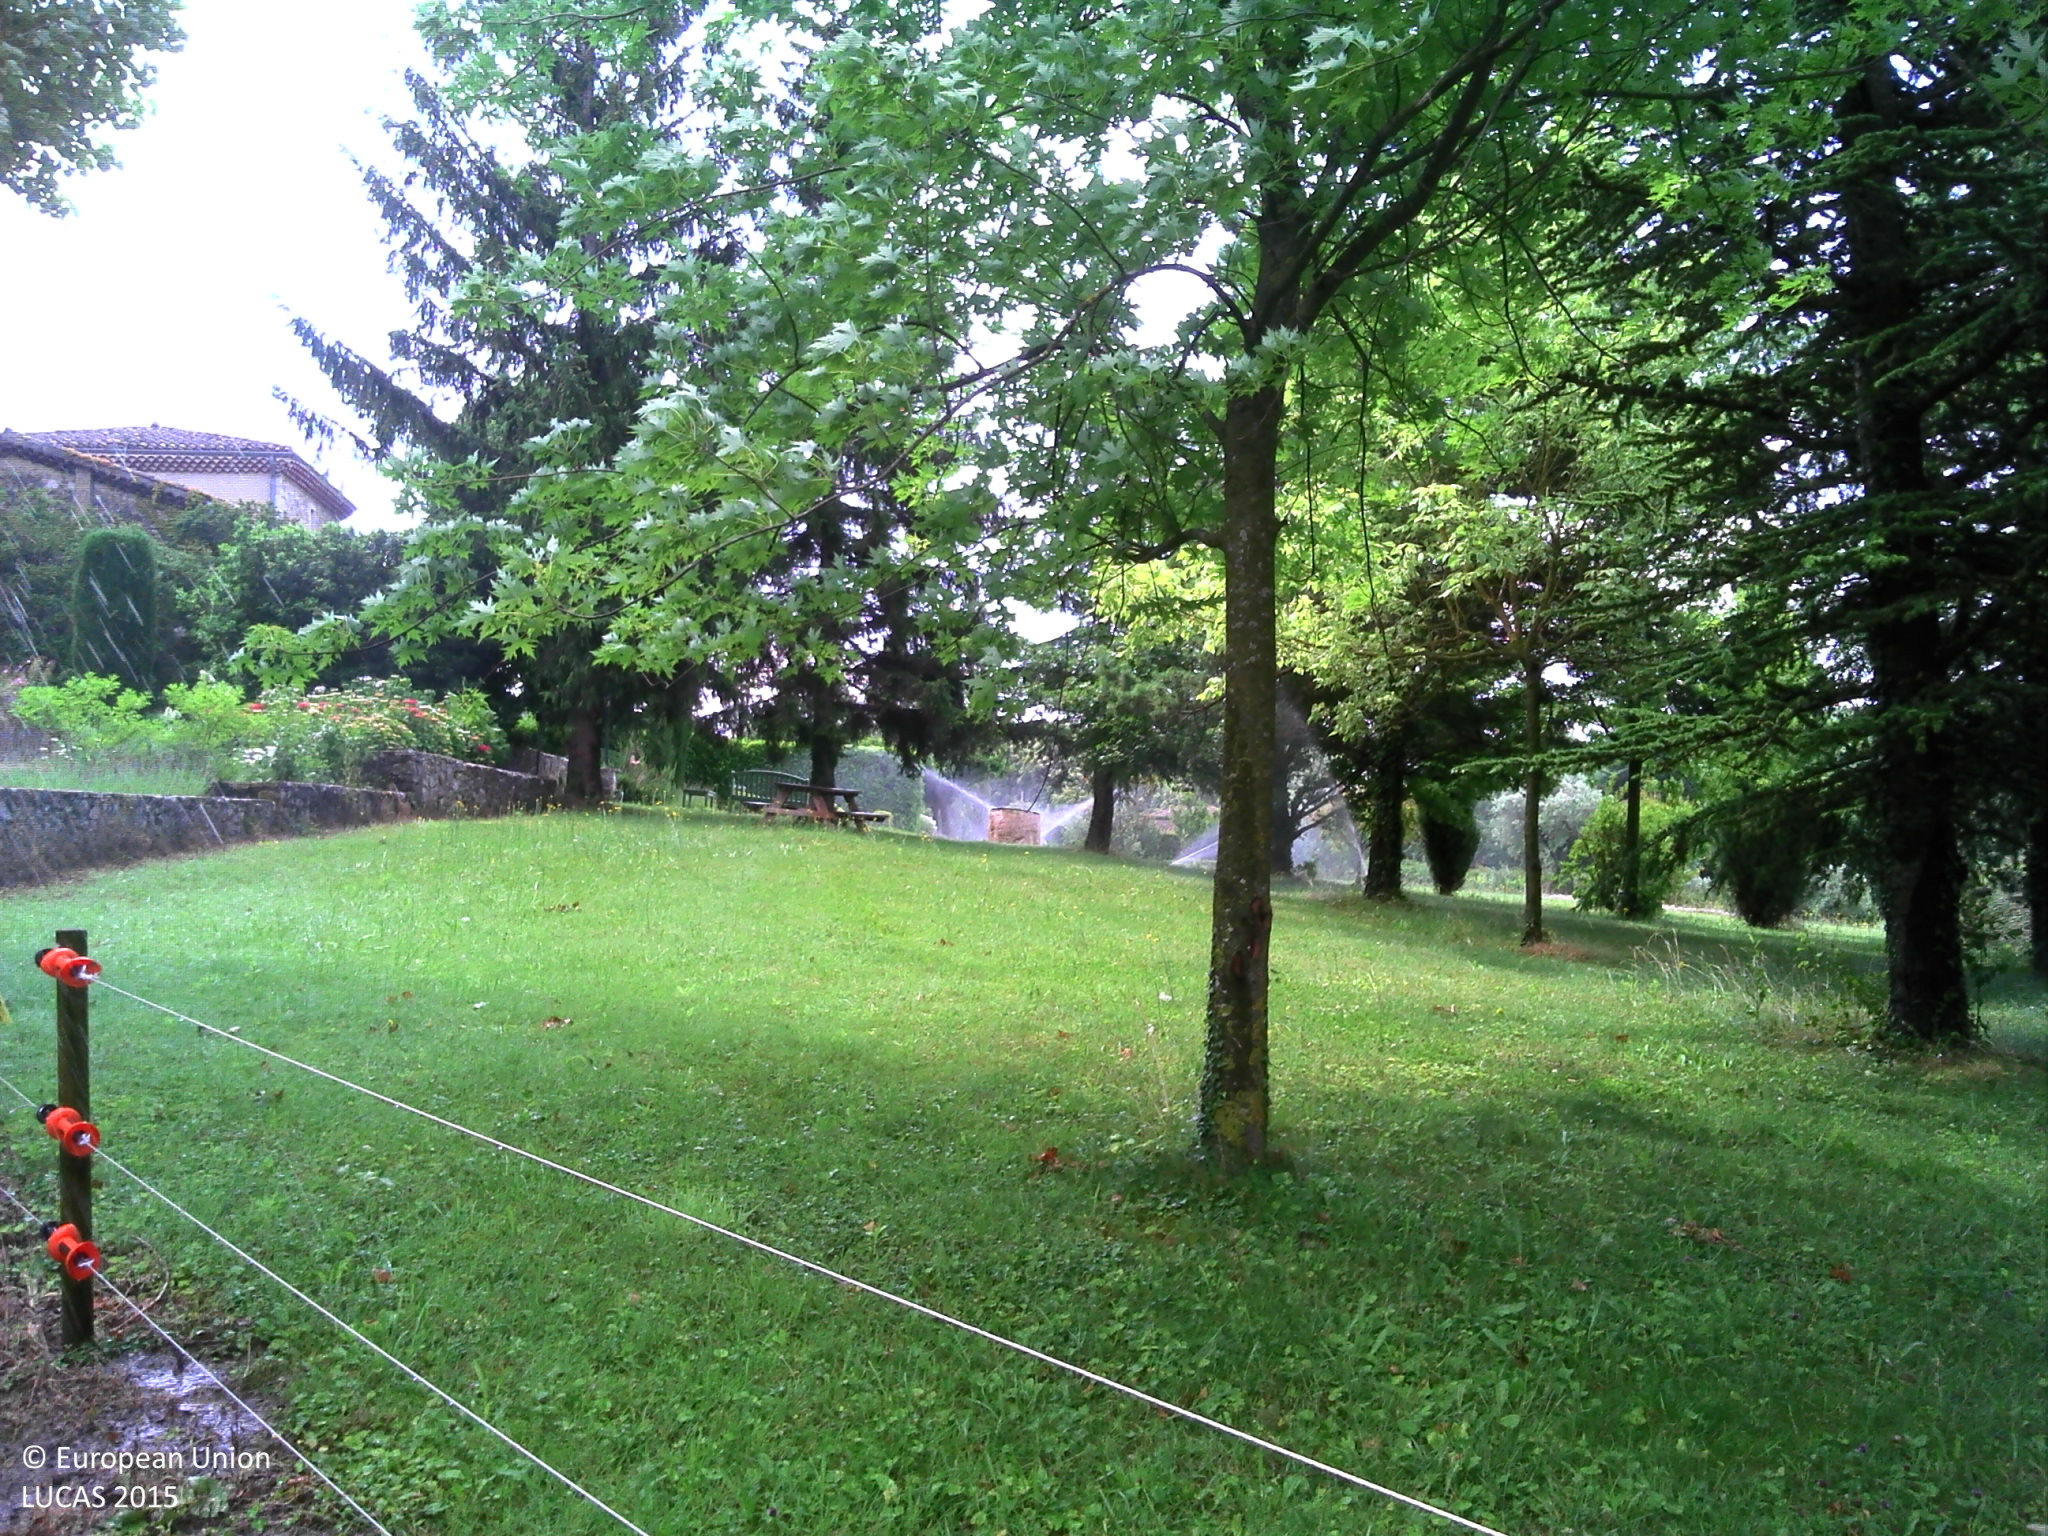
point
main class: Grassland
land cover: Grassland with sparse tree/shrub cover
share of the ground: > 75 %
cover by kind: herbaceous plants 95 %, broadleaved forest trees 5 %
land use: Residential
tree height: > 5 m
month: June
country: FR
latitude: 44.7919
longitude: 5.0386
